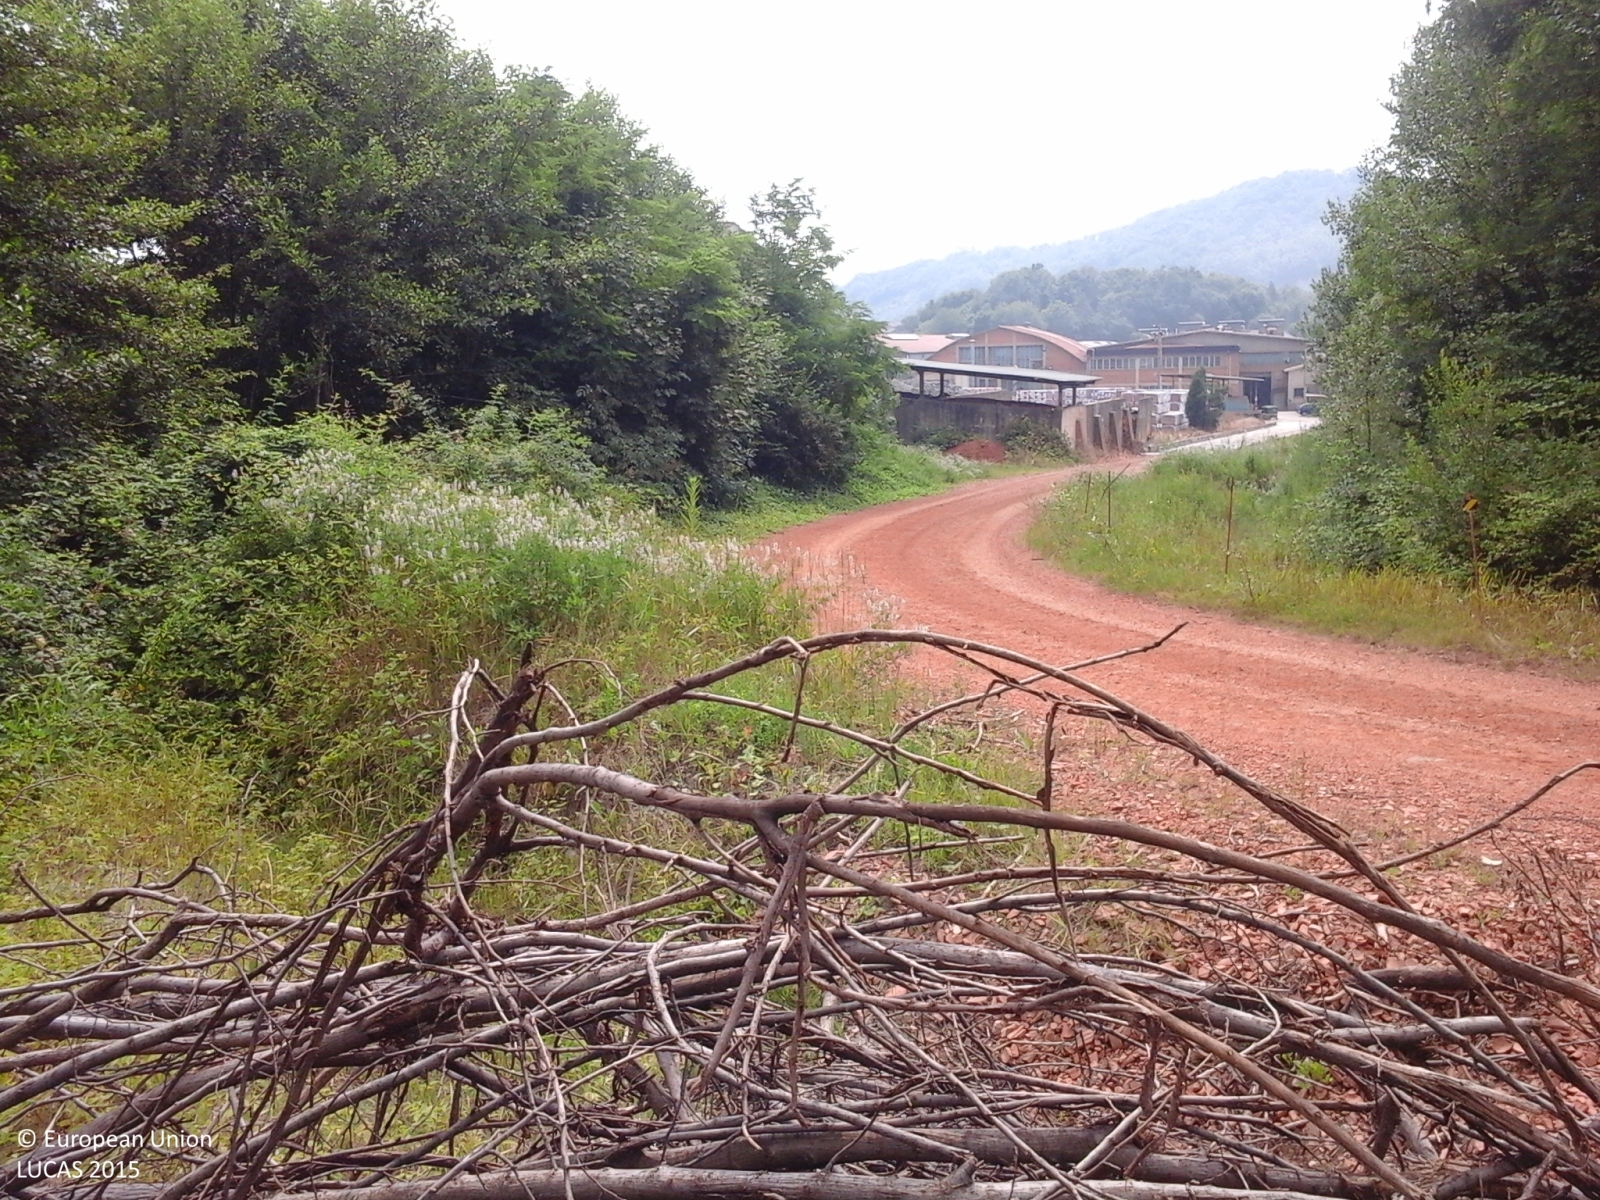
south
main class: Woodland
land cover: Broadleaved woodland
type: thermophilous deciduous forest
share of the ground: > 75 %
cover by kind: broadleaved forest trees 100 %
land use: Semi-natural and natural areas not in use
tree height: > 5 m
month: July
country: IT
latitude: 45.8484
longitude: 11.8645
